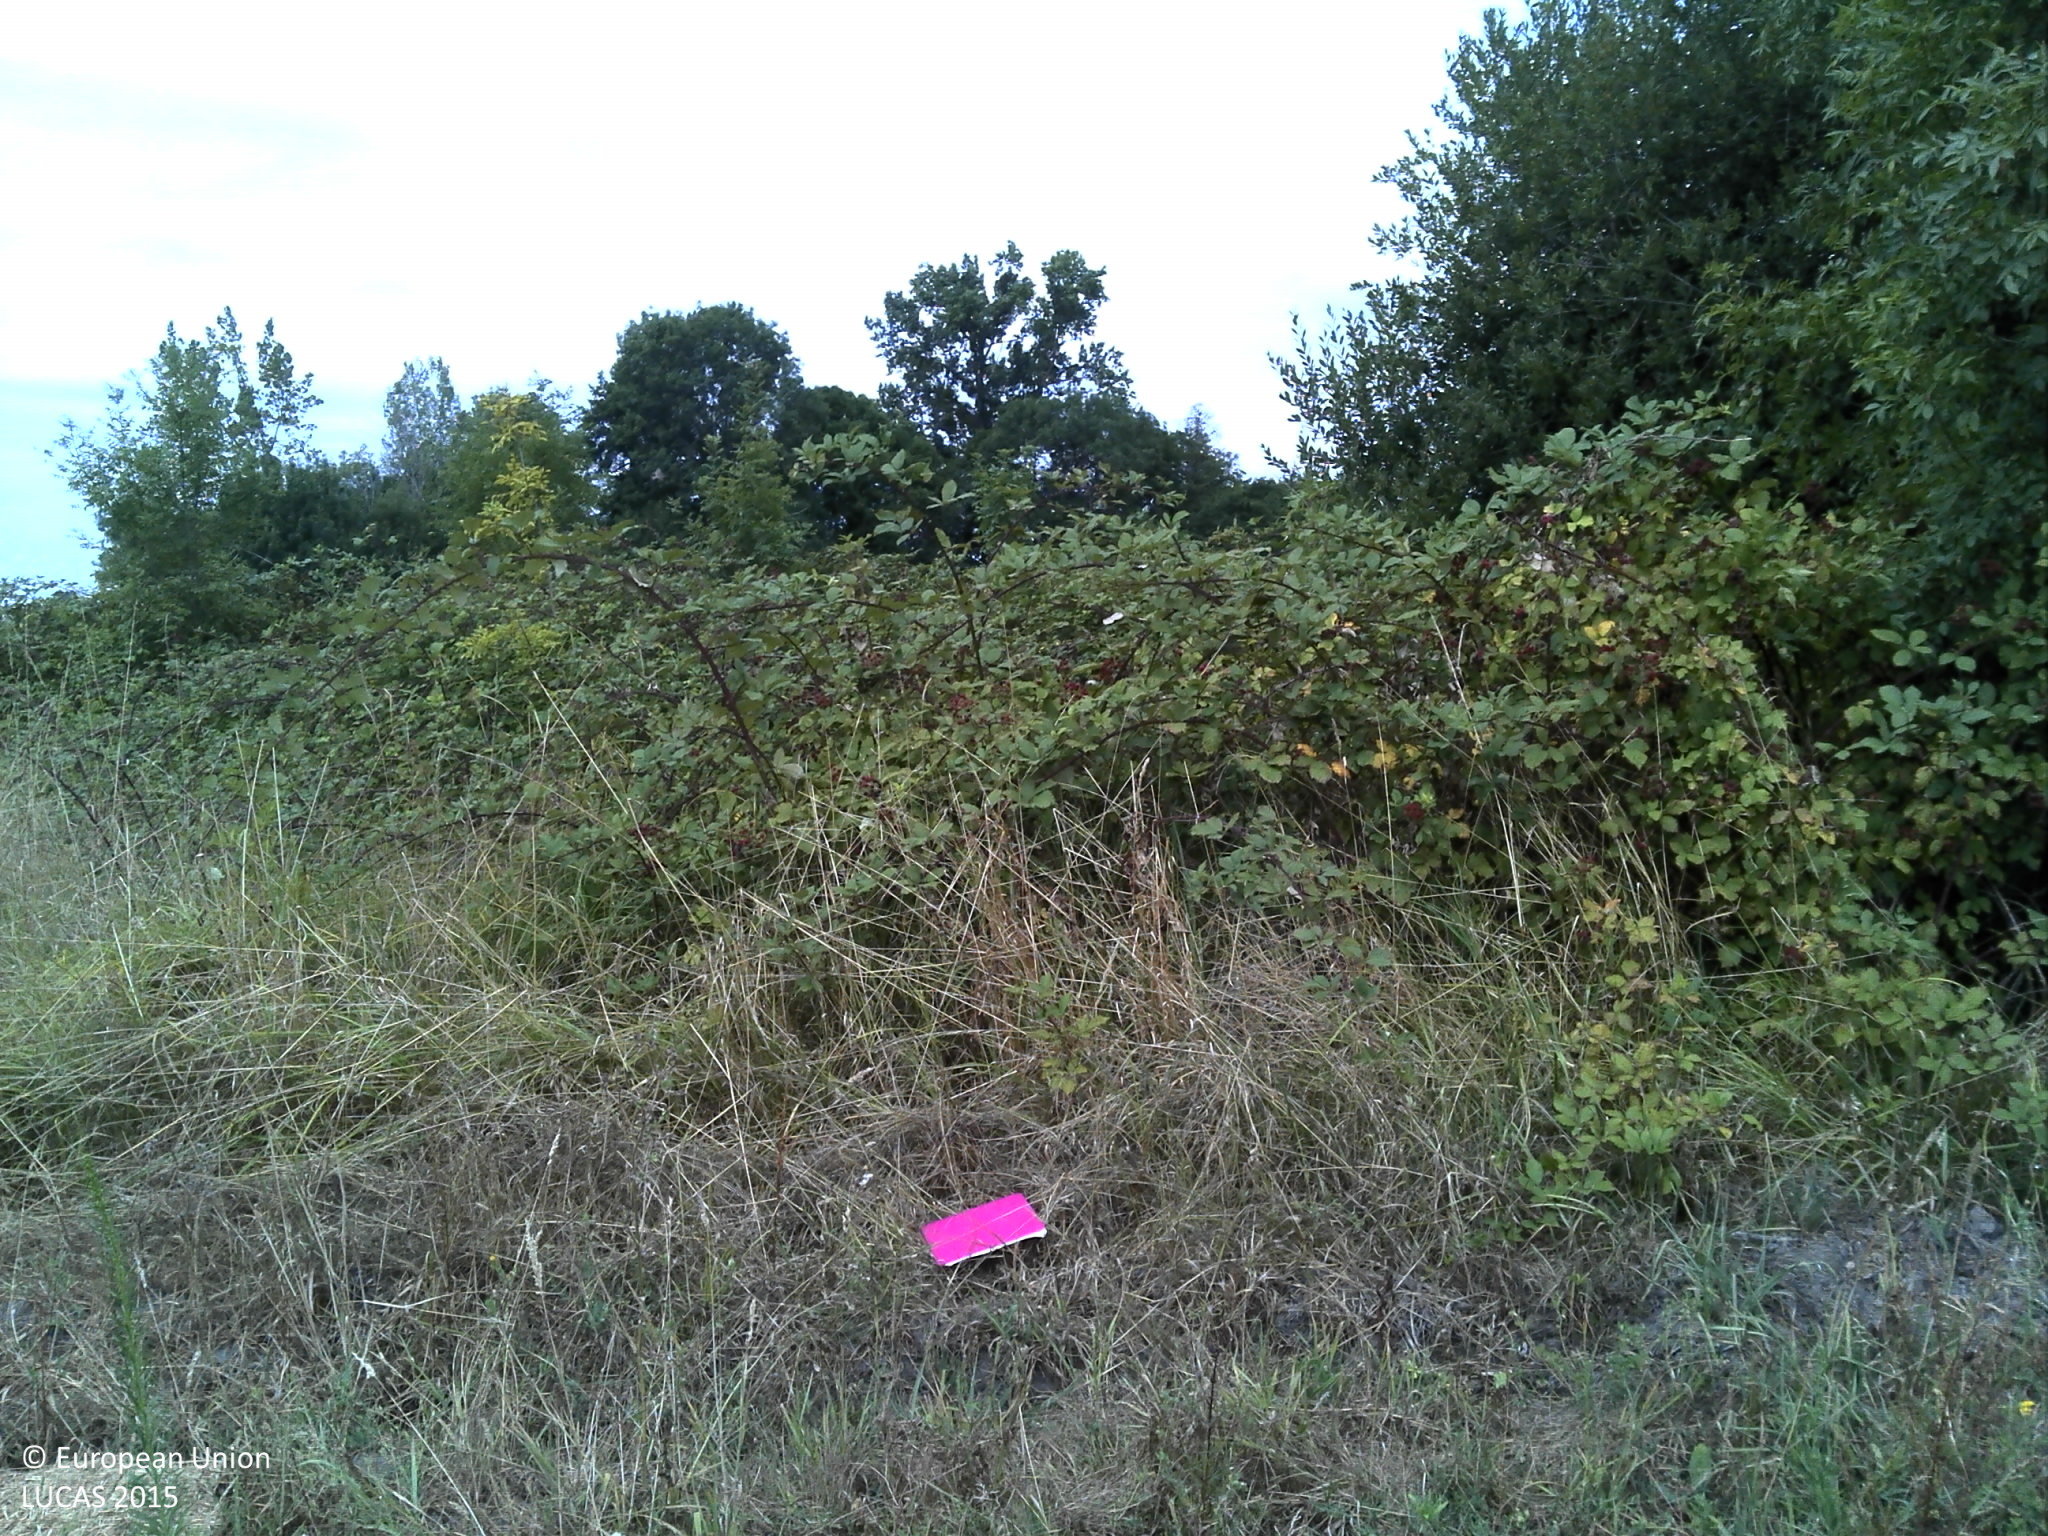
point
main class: Woodland
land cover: Broadleaved woodland
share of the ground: > 75 %
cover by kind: broadleaved forest trees 70 %, shrubs 30 %
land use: Semi-natural and natural areas not in use
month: August
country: FR
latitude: 45.2054
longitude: -0.6007
